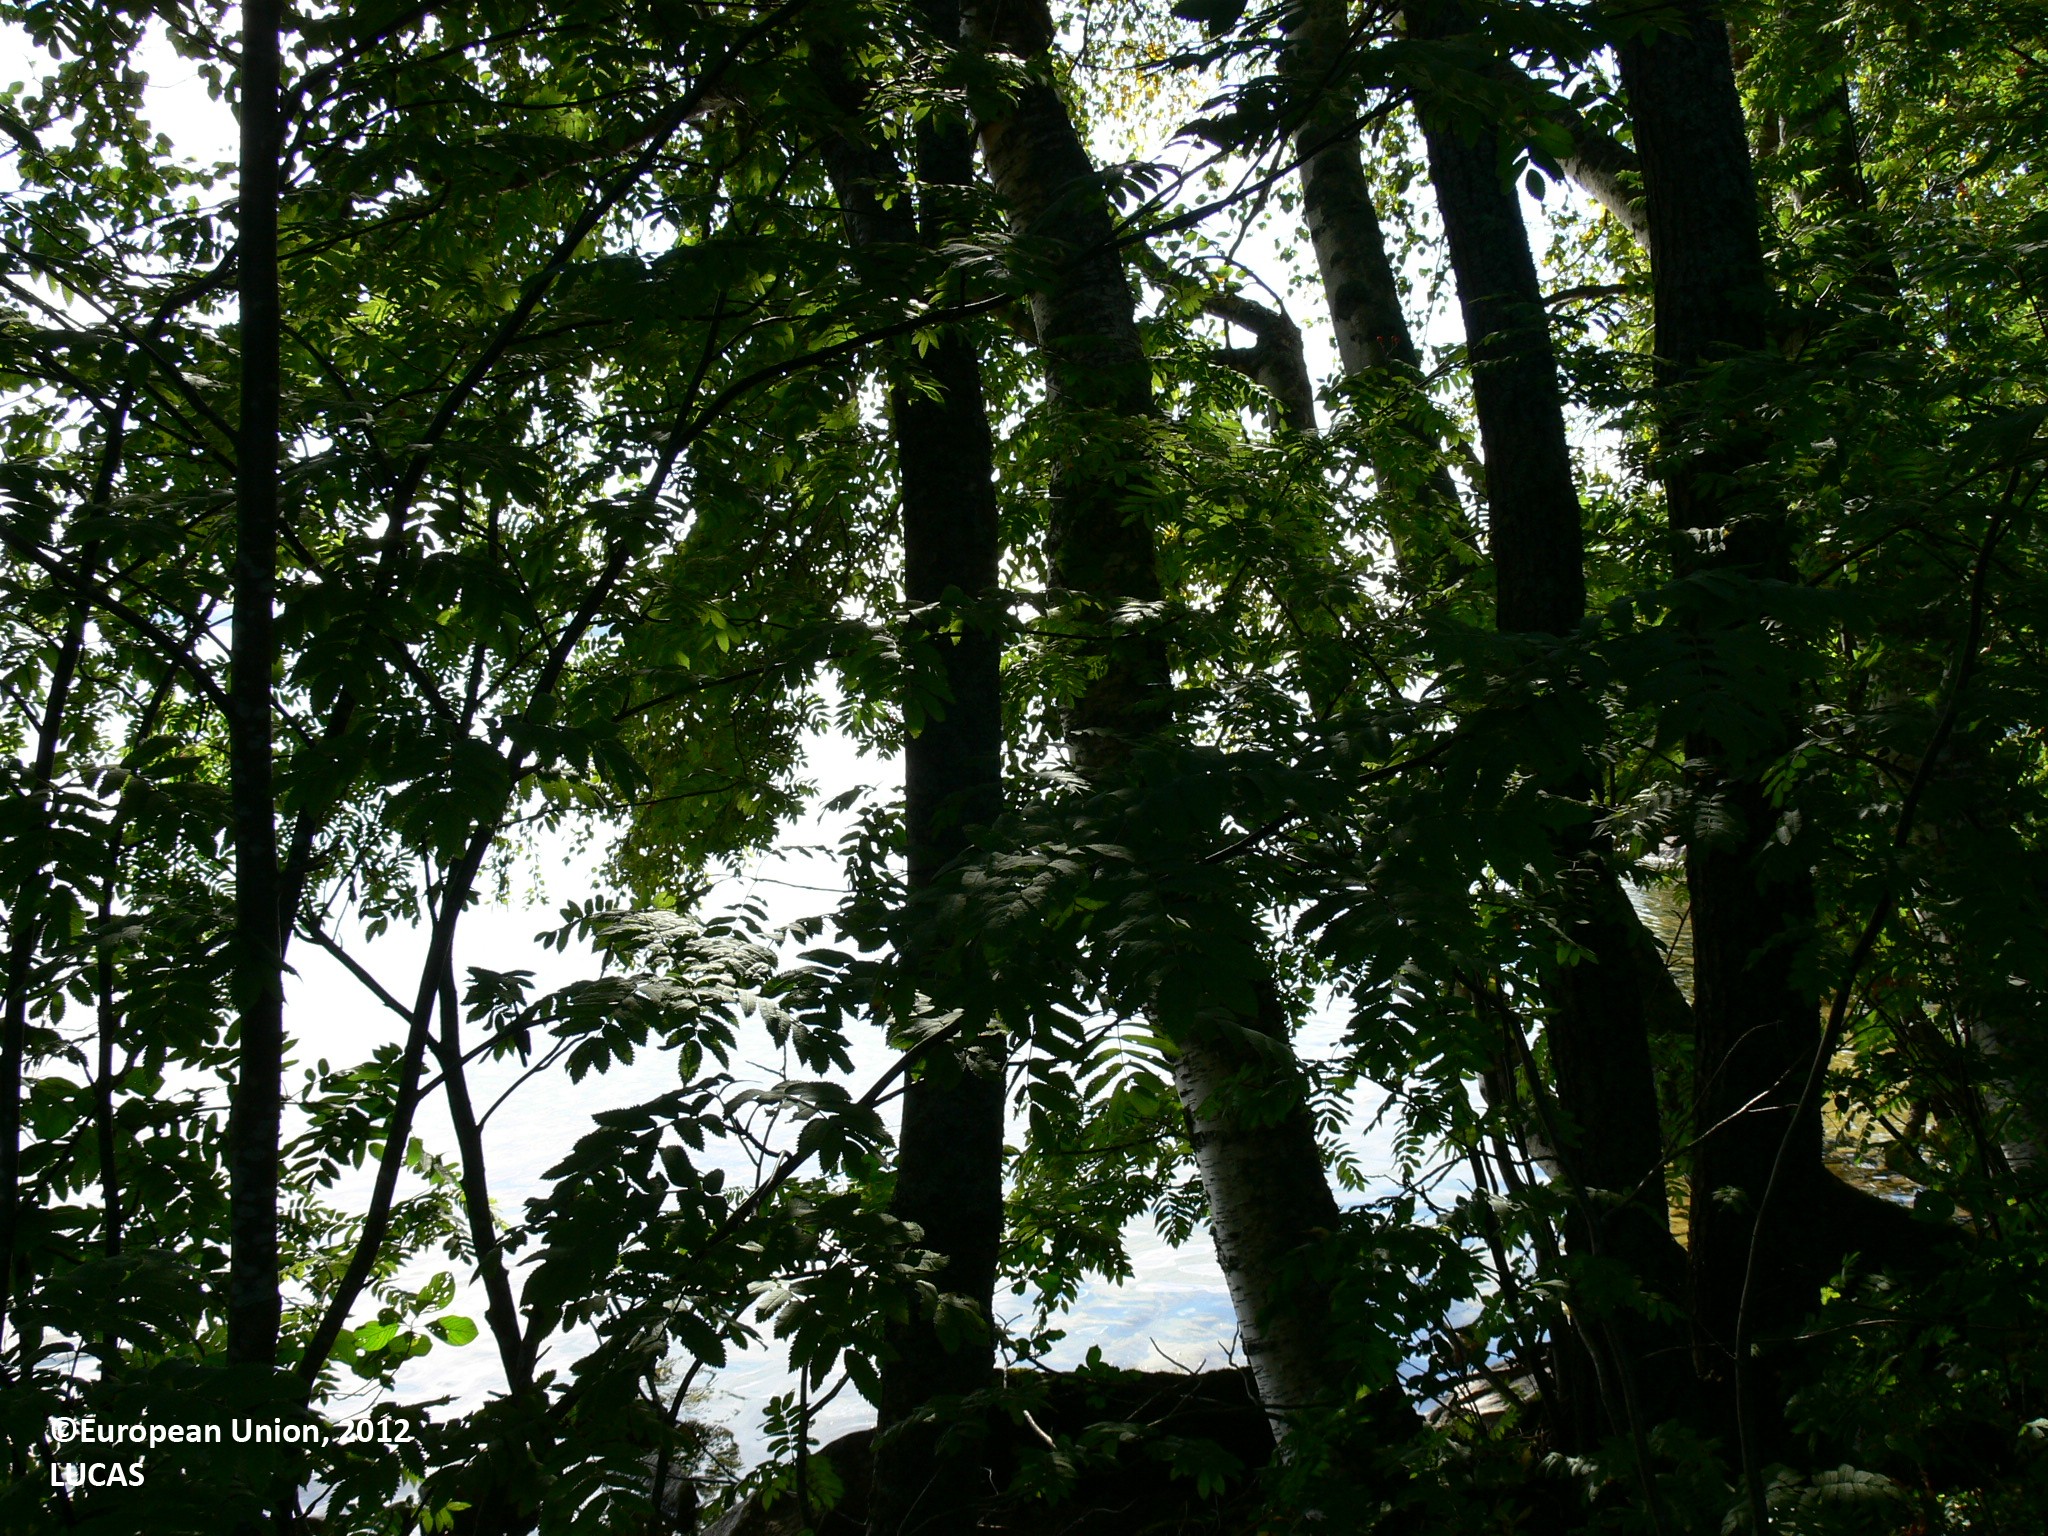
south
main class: Woodland
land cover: Broadleaved woodland
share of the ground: 50 - 75 %
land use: Forestry
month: August
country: FI
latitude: 61.9180
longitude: 30.0150
